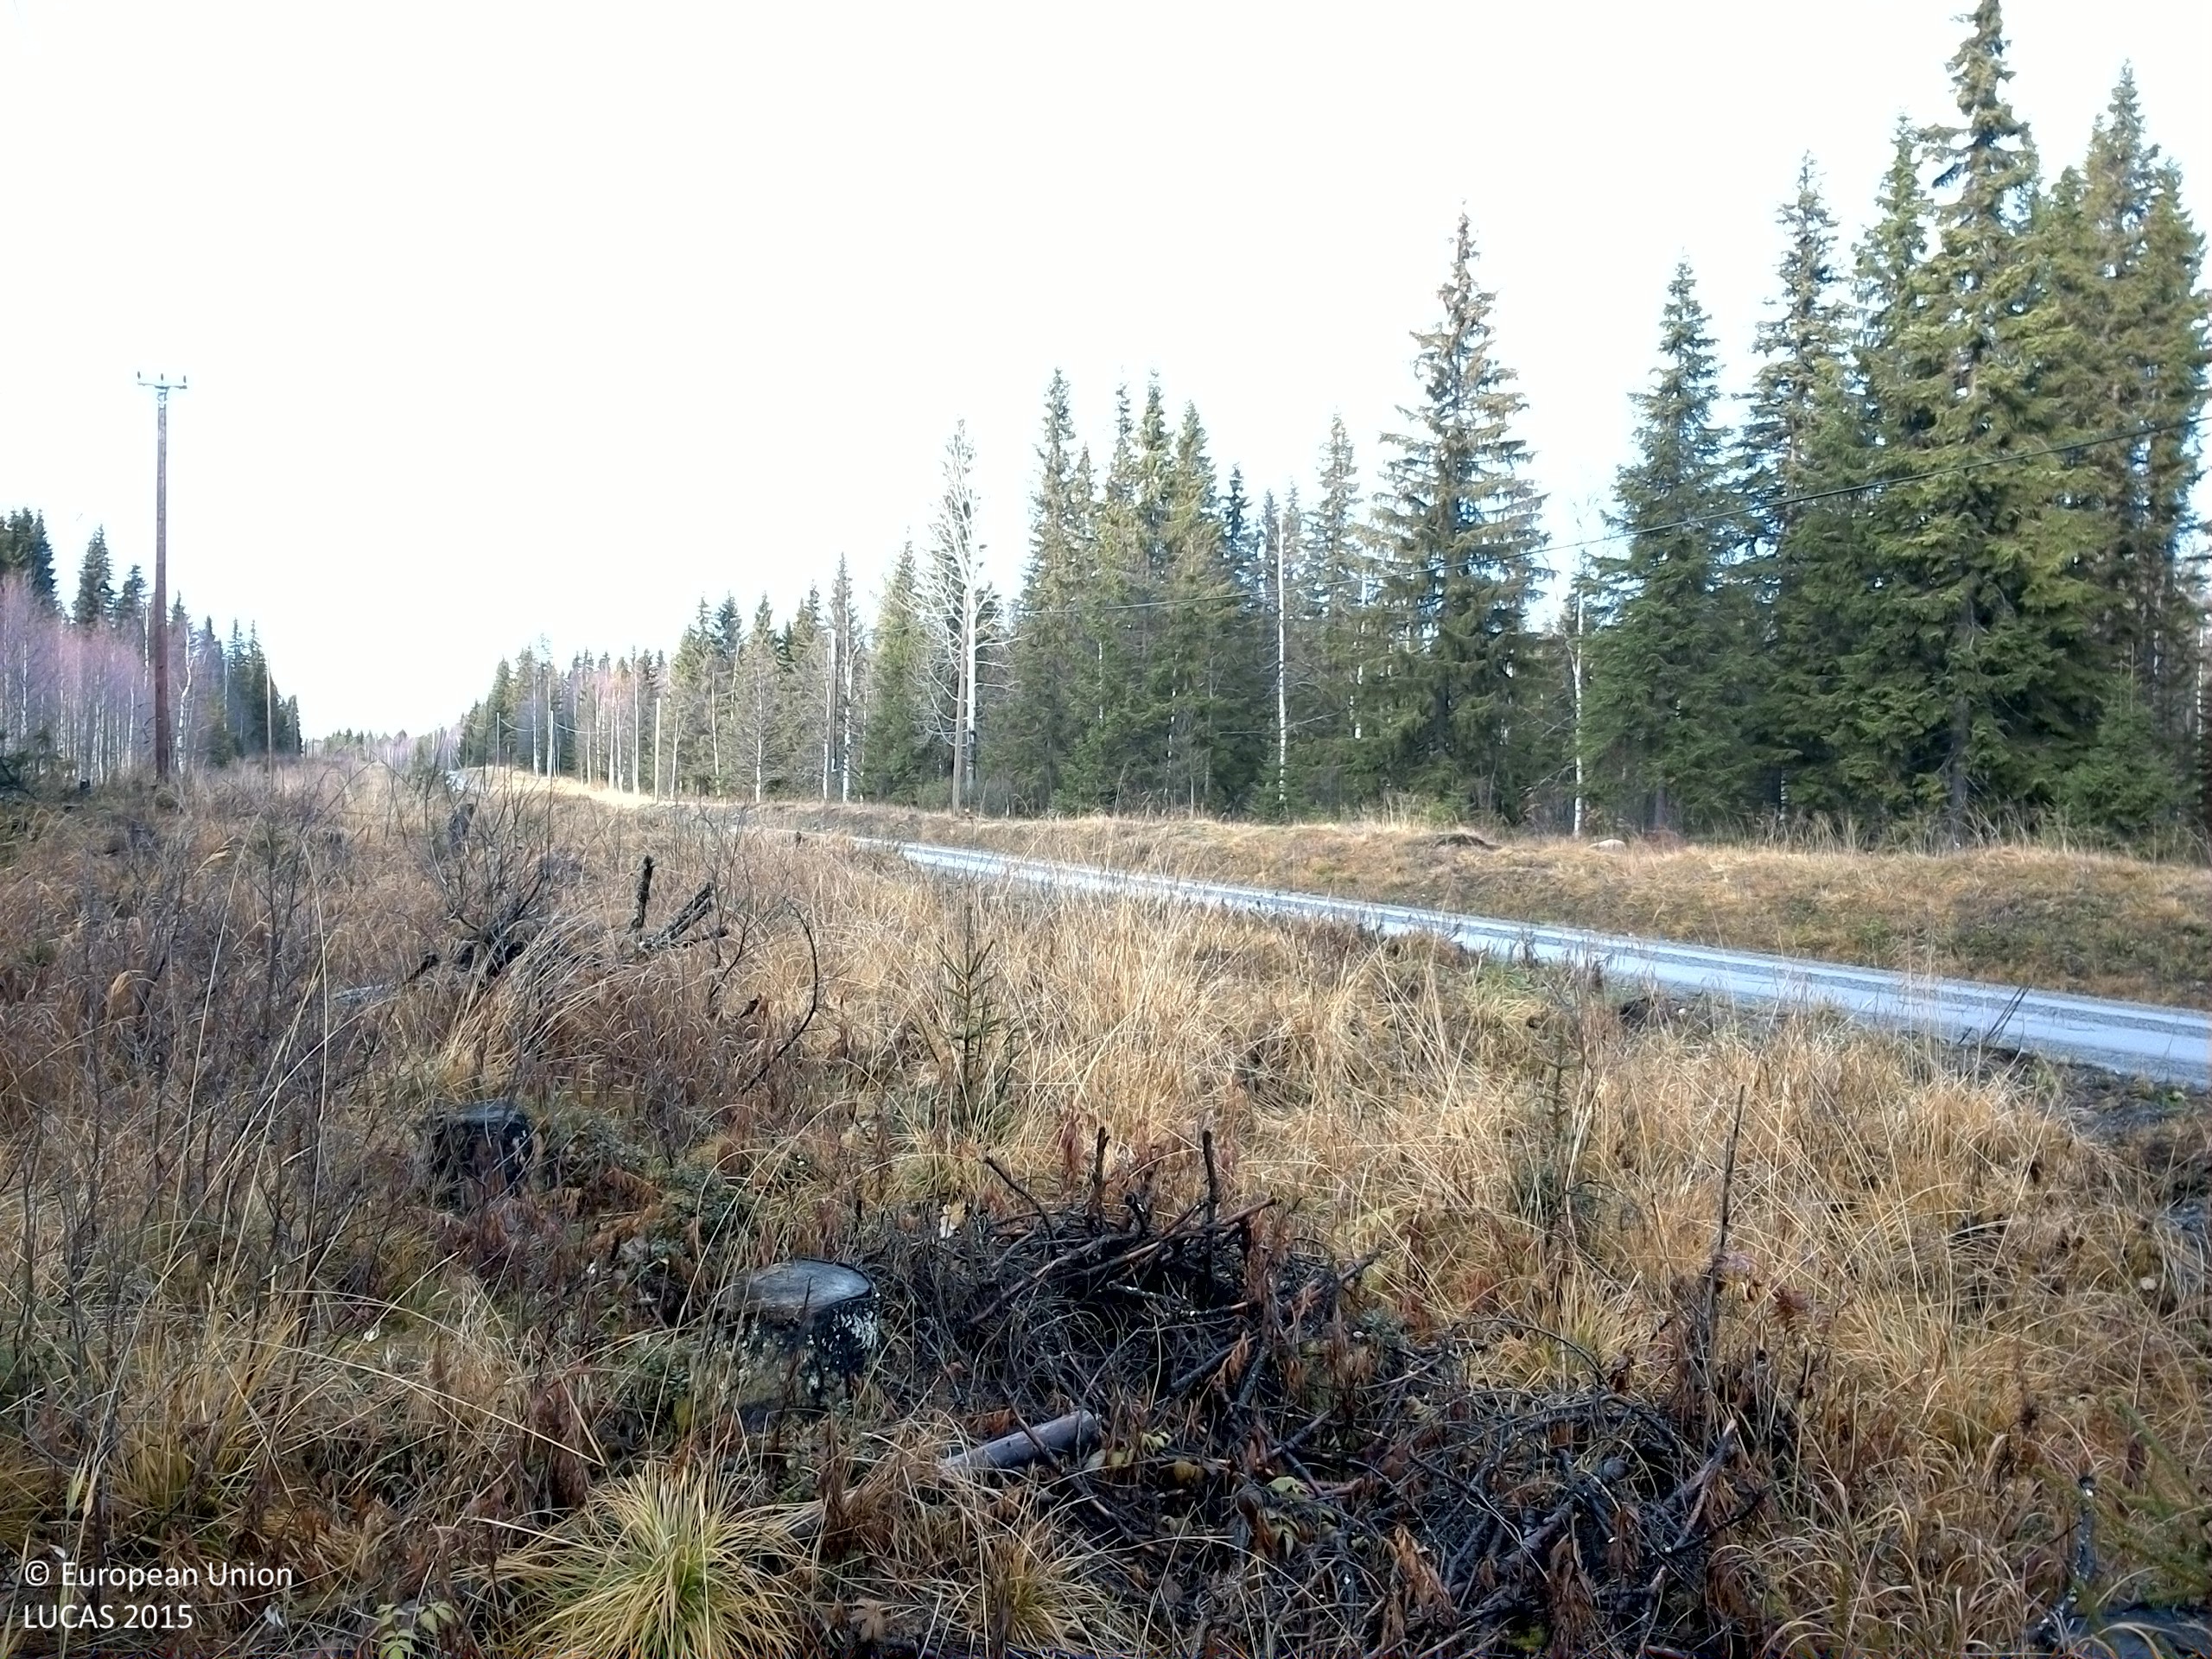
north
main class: Woodland
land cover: Broadleaved woodland
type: boreal forest
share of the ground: > 75 %
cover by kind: herbaceous plants 80 %, broadleaved forest trees 10 %, unconsolidated bare surface 10 %
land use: Forestry
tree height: < 5 m
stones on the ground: 10 - 25 %
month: October
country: SE
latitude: 63.7458
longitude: 15.3842
